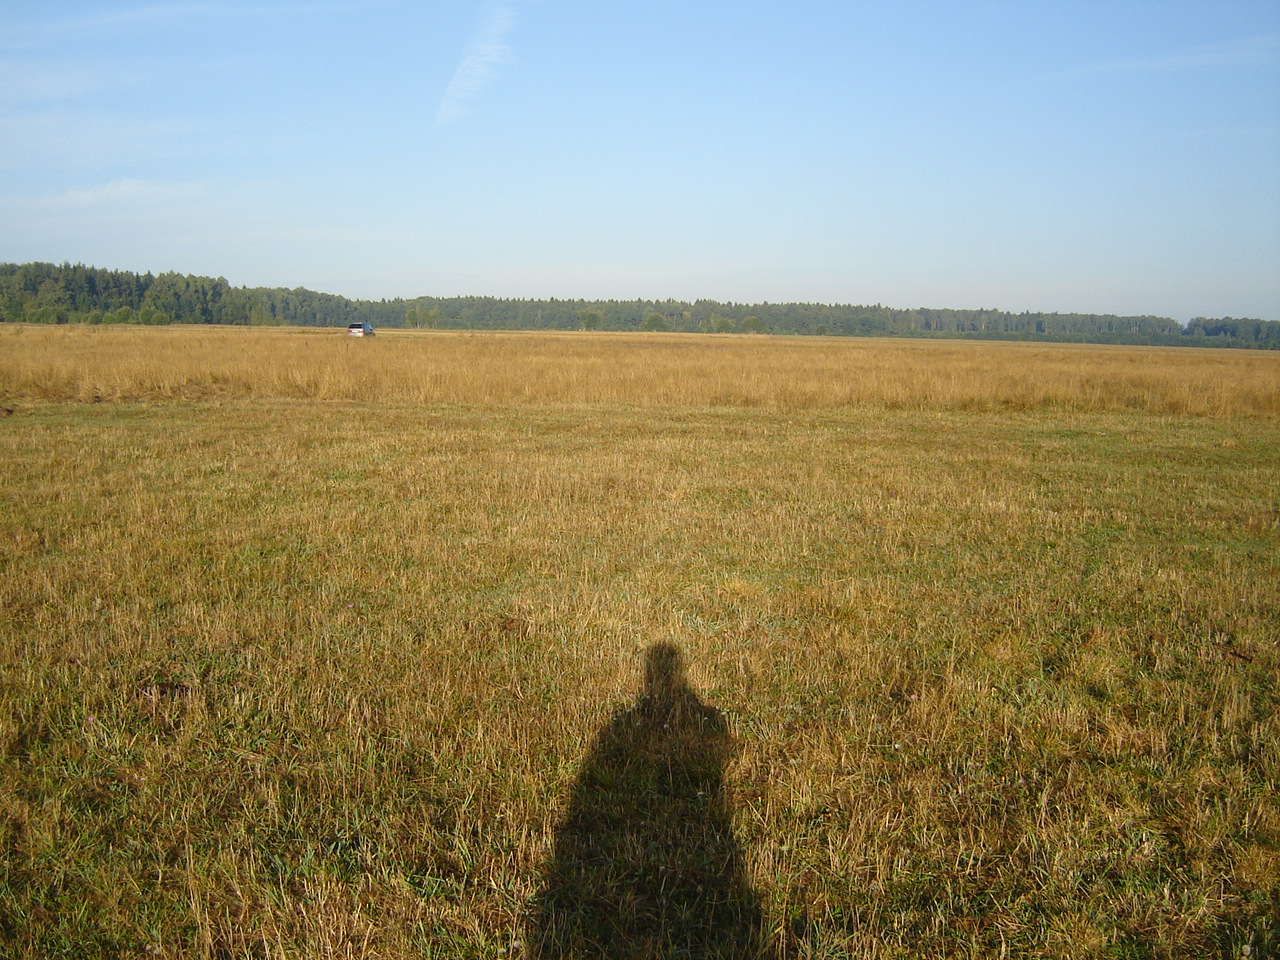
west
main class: Grassland
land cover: Grassland without tree/shrub cover
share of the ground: > 75 %
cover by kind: herbaceous plants 100 %
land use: Agriculture (excluding fallow land and kitchen gardens)
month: September
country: LT
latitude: 54.2383
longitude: 24.9827
